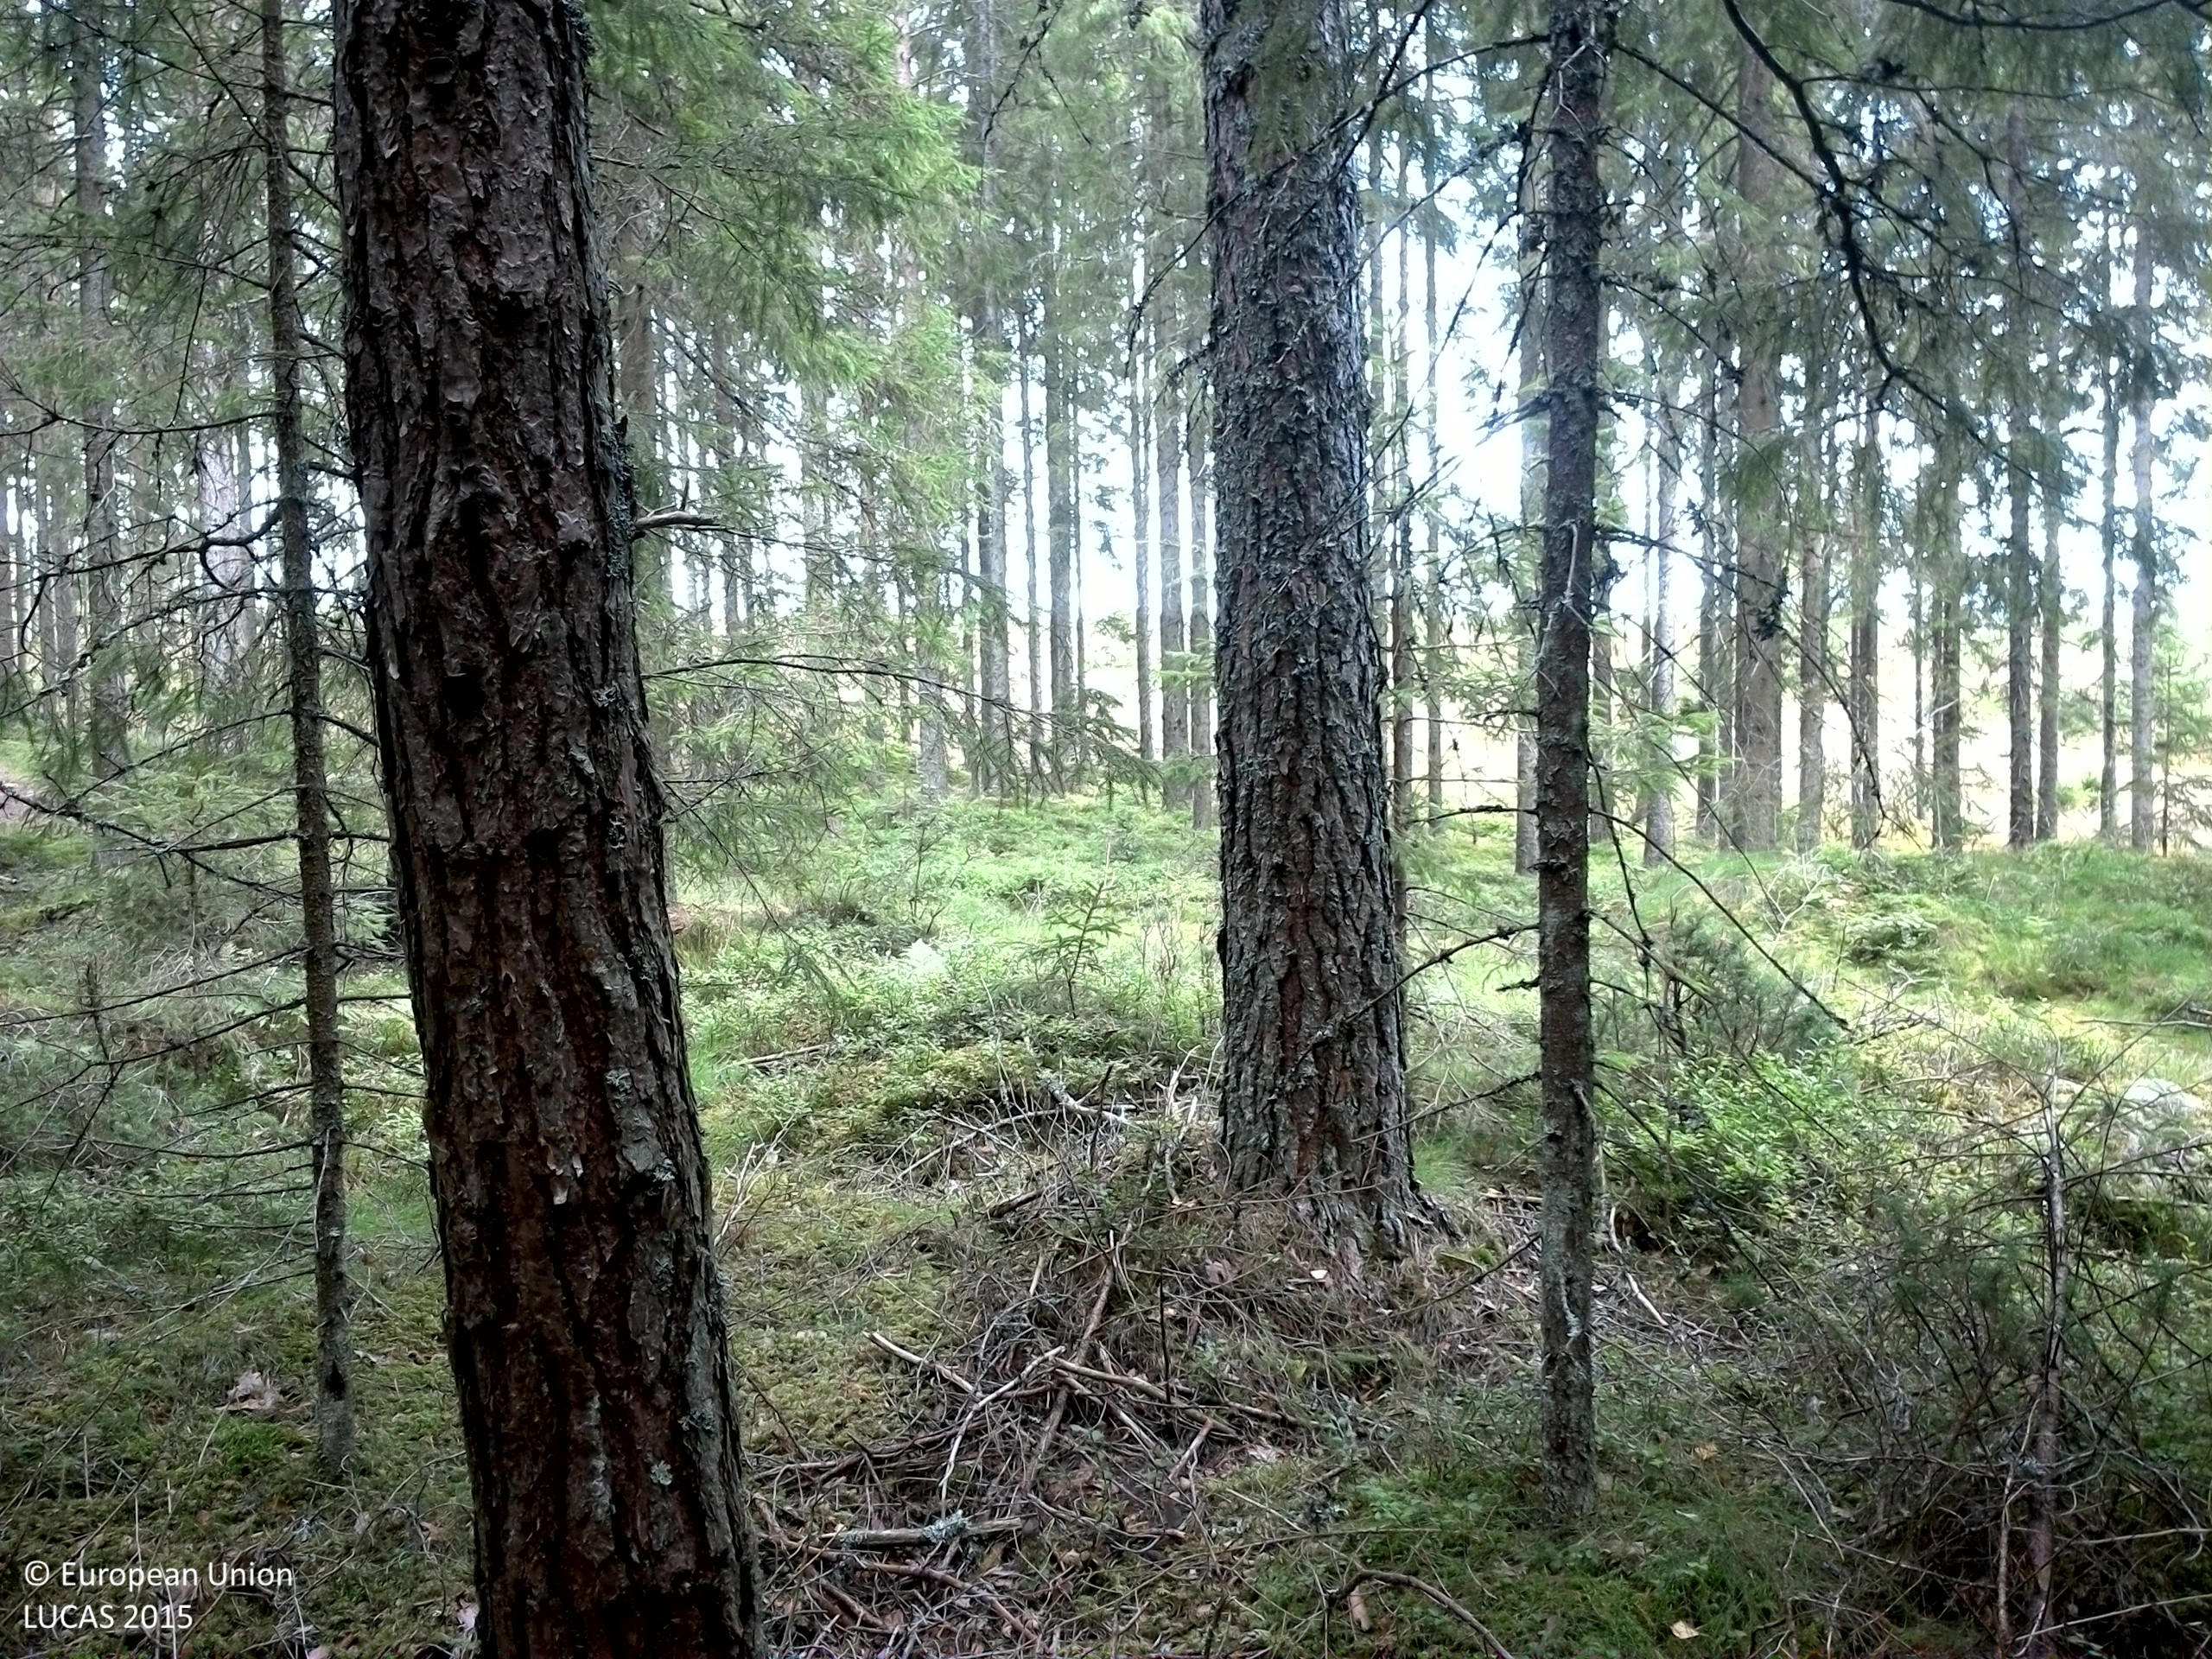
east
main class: Woodland
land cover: Spruce dominated coniferous woodland
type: boreal forest
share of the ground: 50 - 75 %
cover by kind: coniferous forest trees 65 %, shrubs 20 %, lichens and mosses 10 %, broadleaved forest trees 5 %
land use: Forestry
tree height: > 5 m
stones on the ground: < 10 %
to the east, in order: Spruce dominated coniferous woodland; Tracks; Spruce dominated coniferous woodland; Shrubland with sparse tree cover; Pine dominated mixed woodland; Tracks; Pine dominated mixed woodland; Spruce dominated mixed woodland
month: September
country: SE
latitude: 59.7589
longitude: 13.4981
